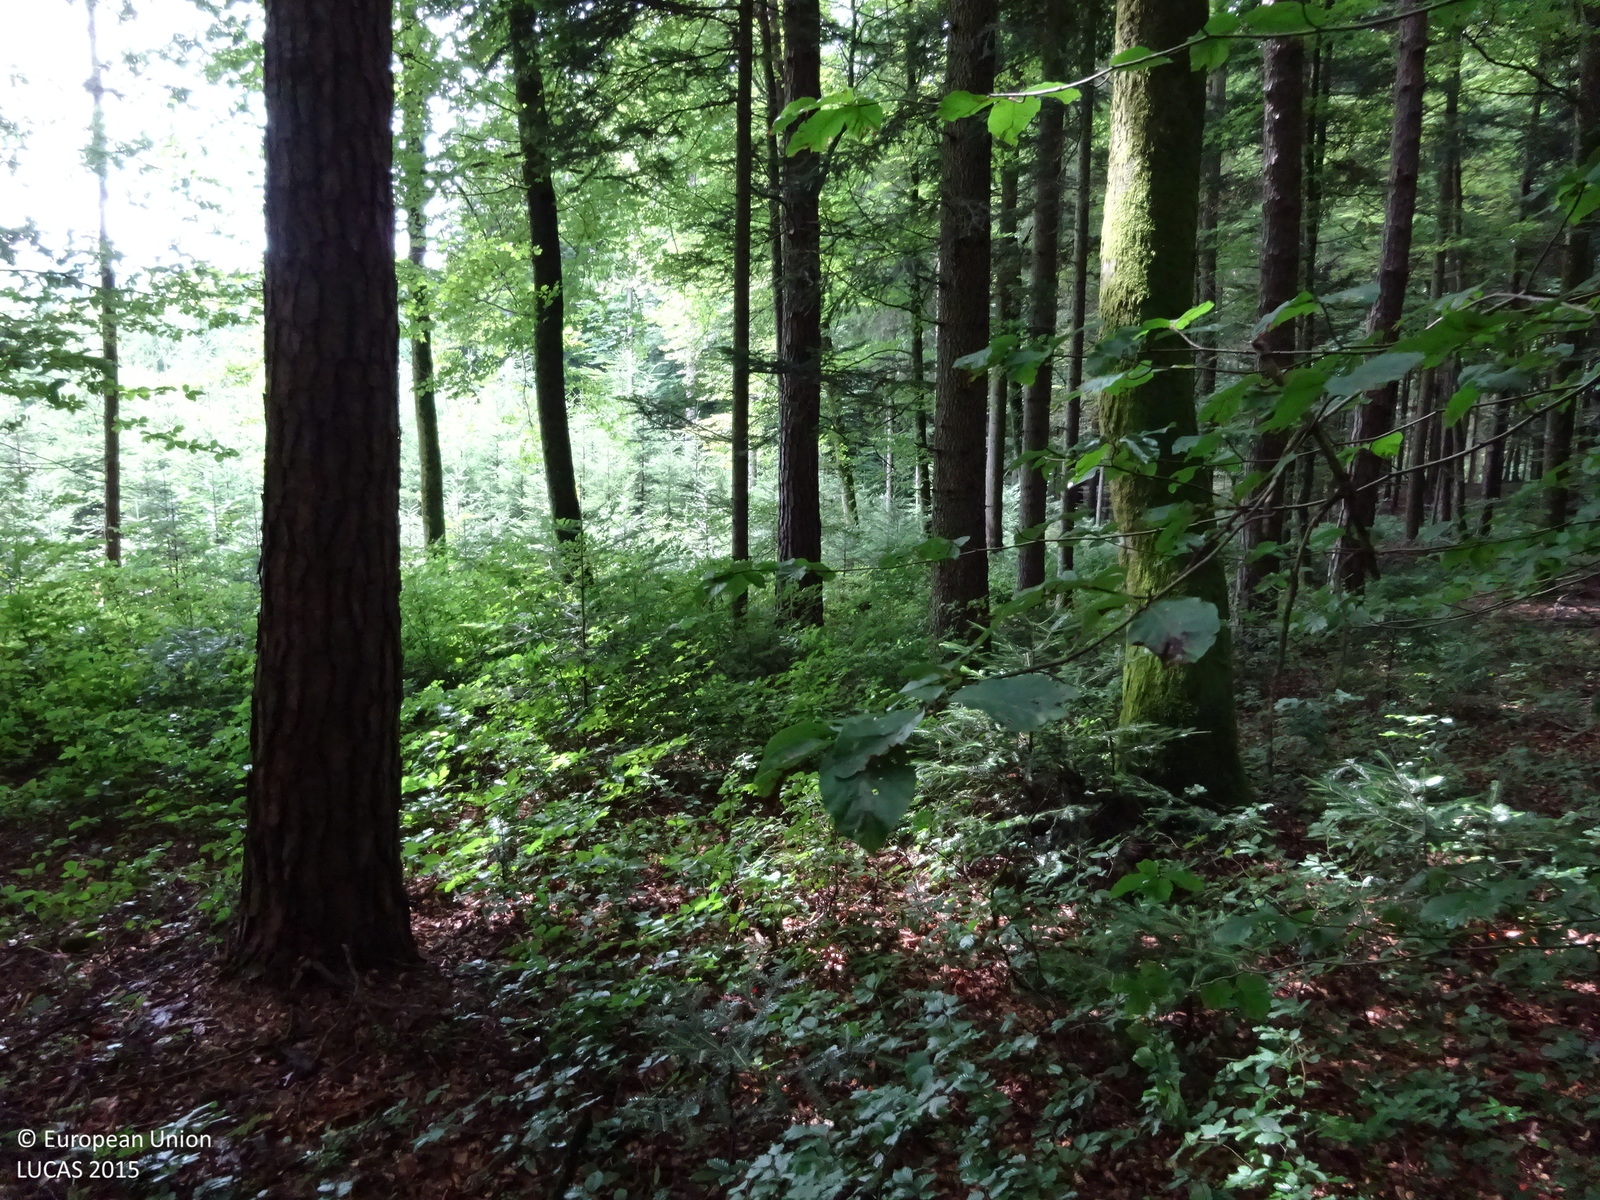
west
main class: Woodland
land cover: Pine dominated mixed woodland
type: mountainous beech forest
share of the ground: > 75 %
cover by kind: broadleaved forest trees 65 %, coniferous forest trees 25 %, herbaceous plants 10 %
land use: Forestry
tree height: > 5 m
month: July
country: AT
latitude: 46.8509
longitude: 15.3106
